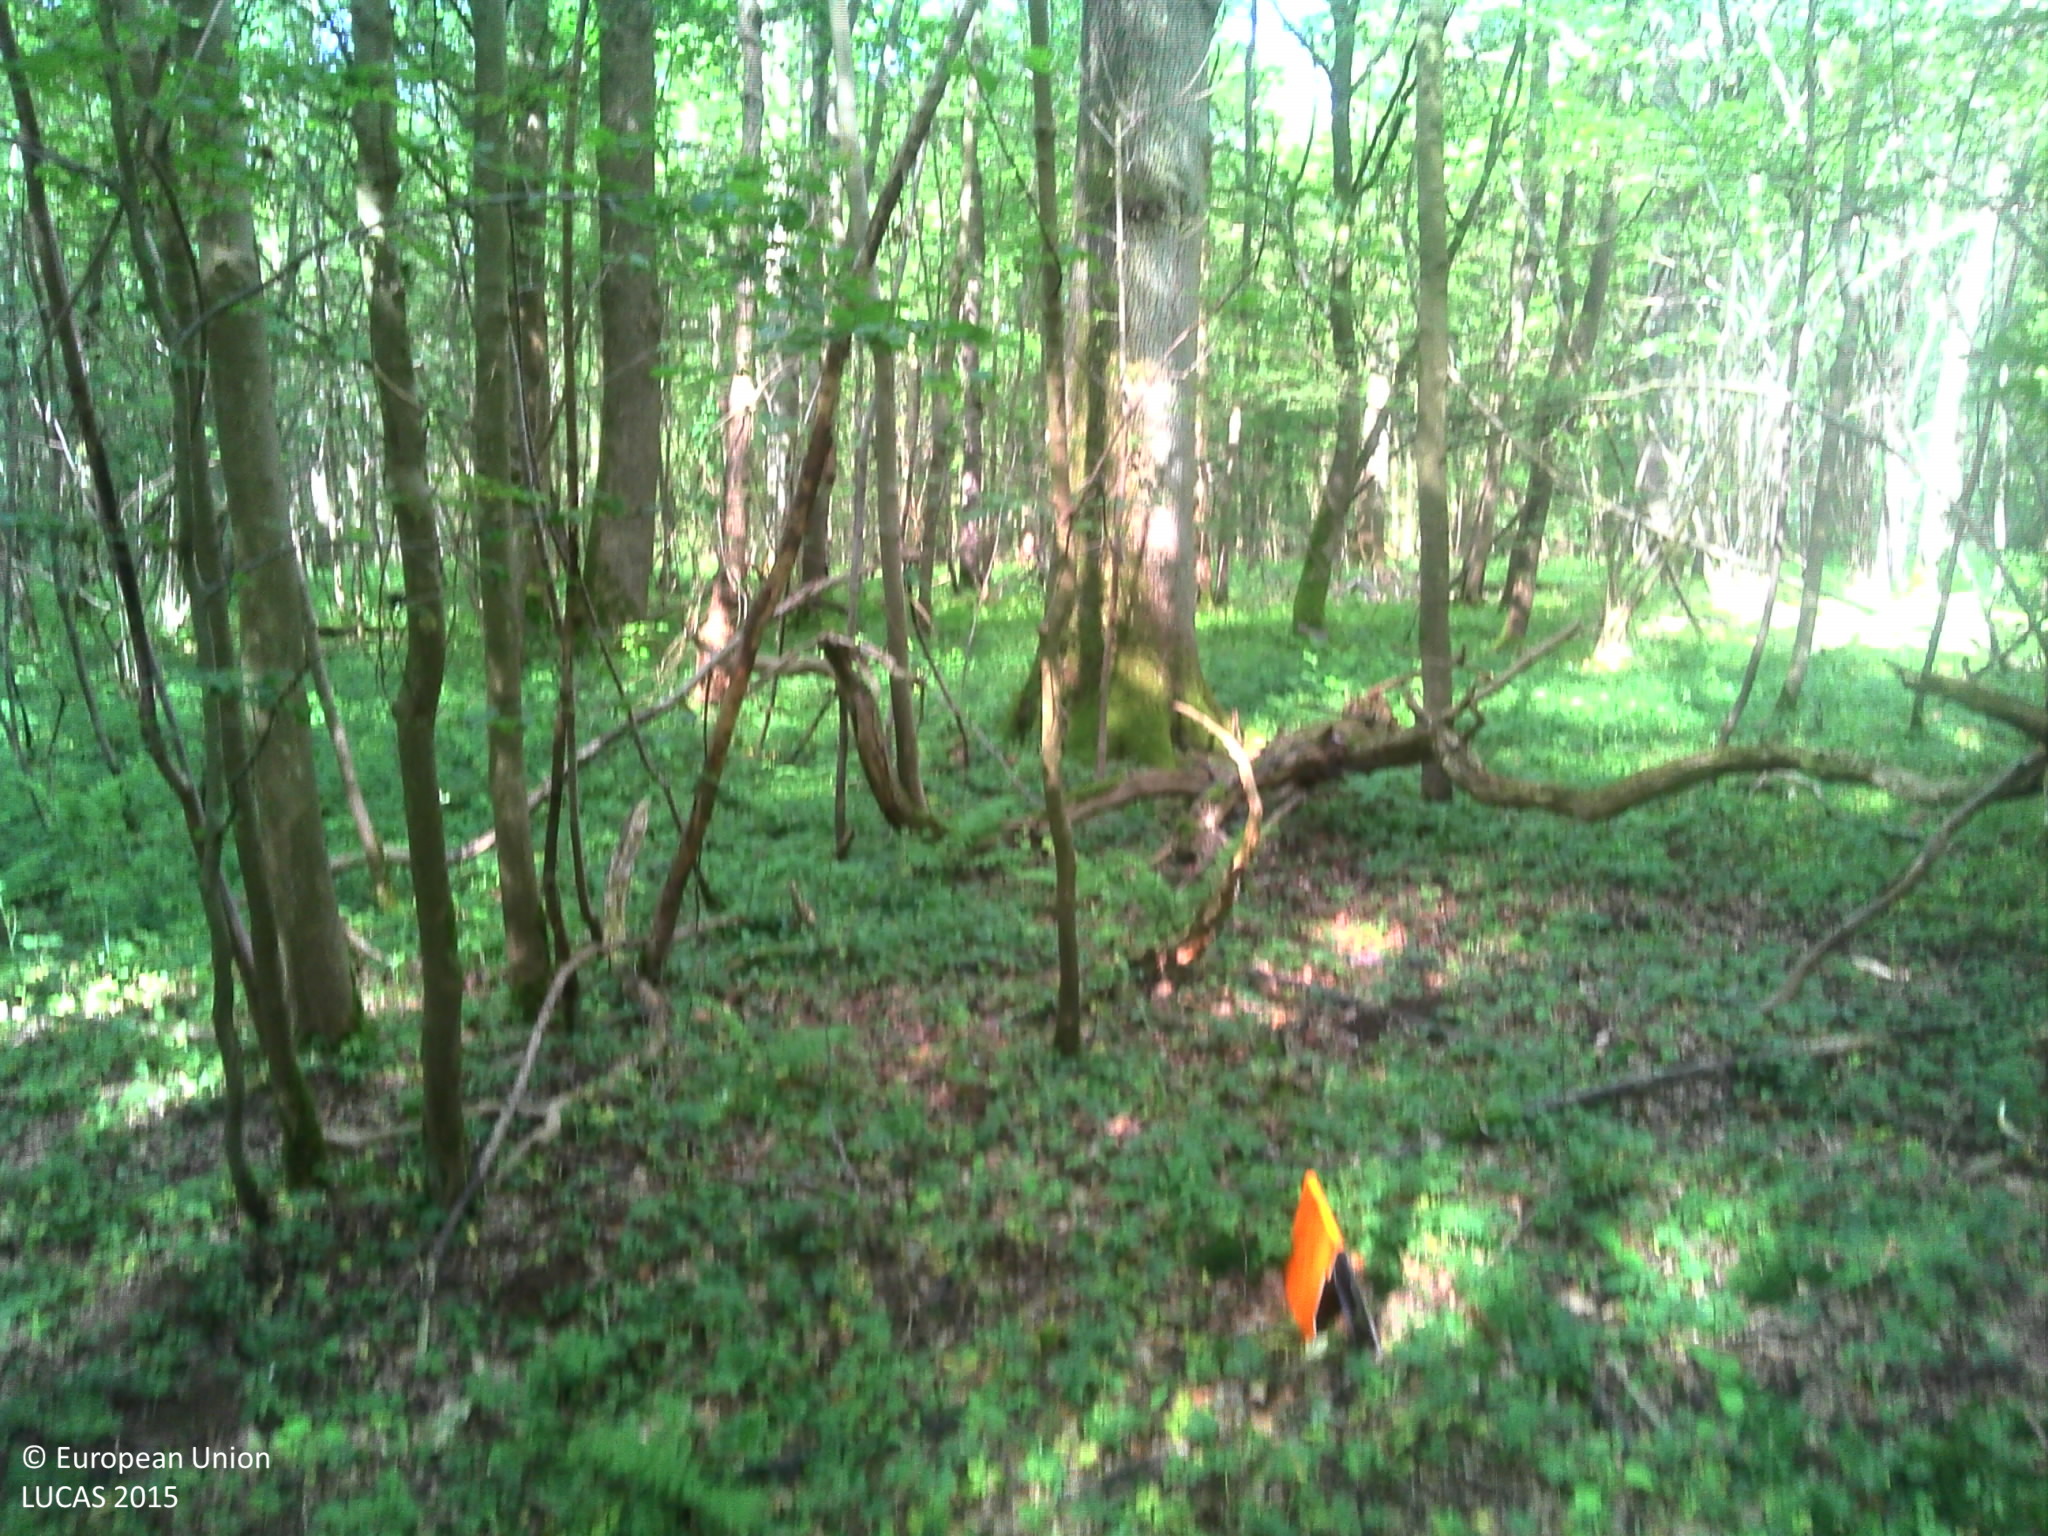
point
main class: Woodland
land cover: Broadleaved woodland
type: mesophytic deciduous forest
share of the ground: > 75 %
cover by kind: broadleaved forest trees 85 %, herbaceous plants 15 %
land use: Forestry
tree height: > 5 m
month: June
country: FR
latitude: 49.6769
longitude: 3.2426
